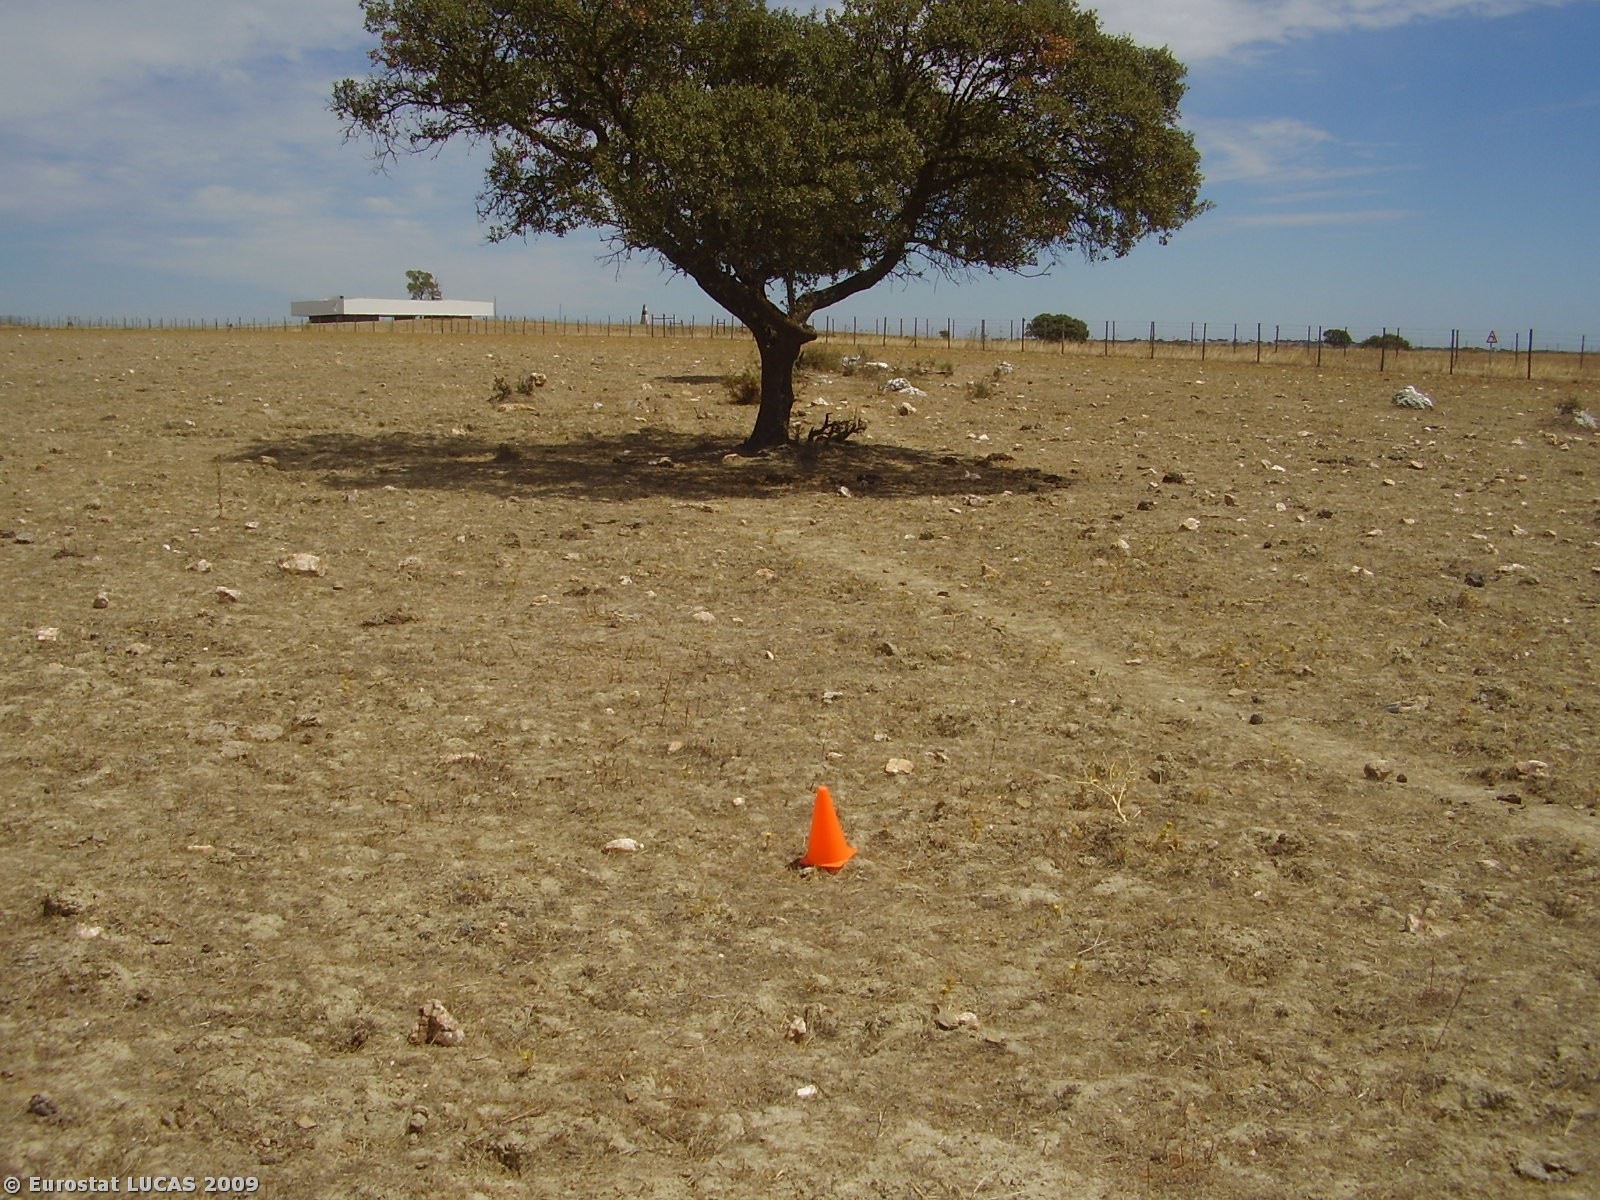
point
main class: Grassland
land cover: Grassland with sparse tree/shrub cover
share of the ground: > 75 %
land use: Fallow land
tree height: > 5 m
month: August
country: PT
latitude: 38.2255
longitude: -7.1621
